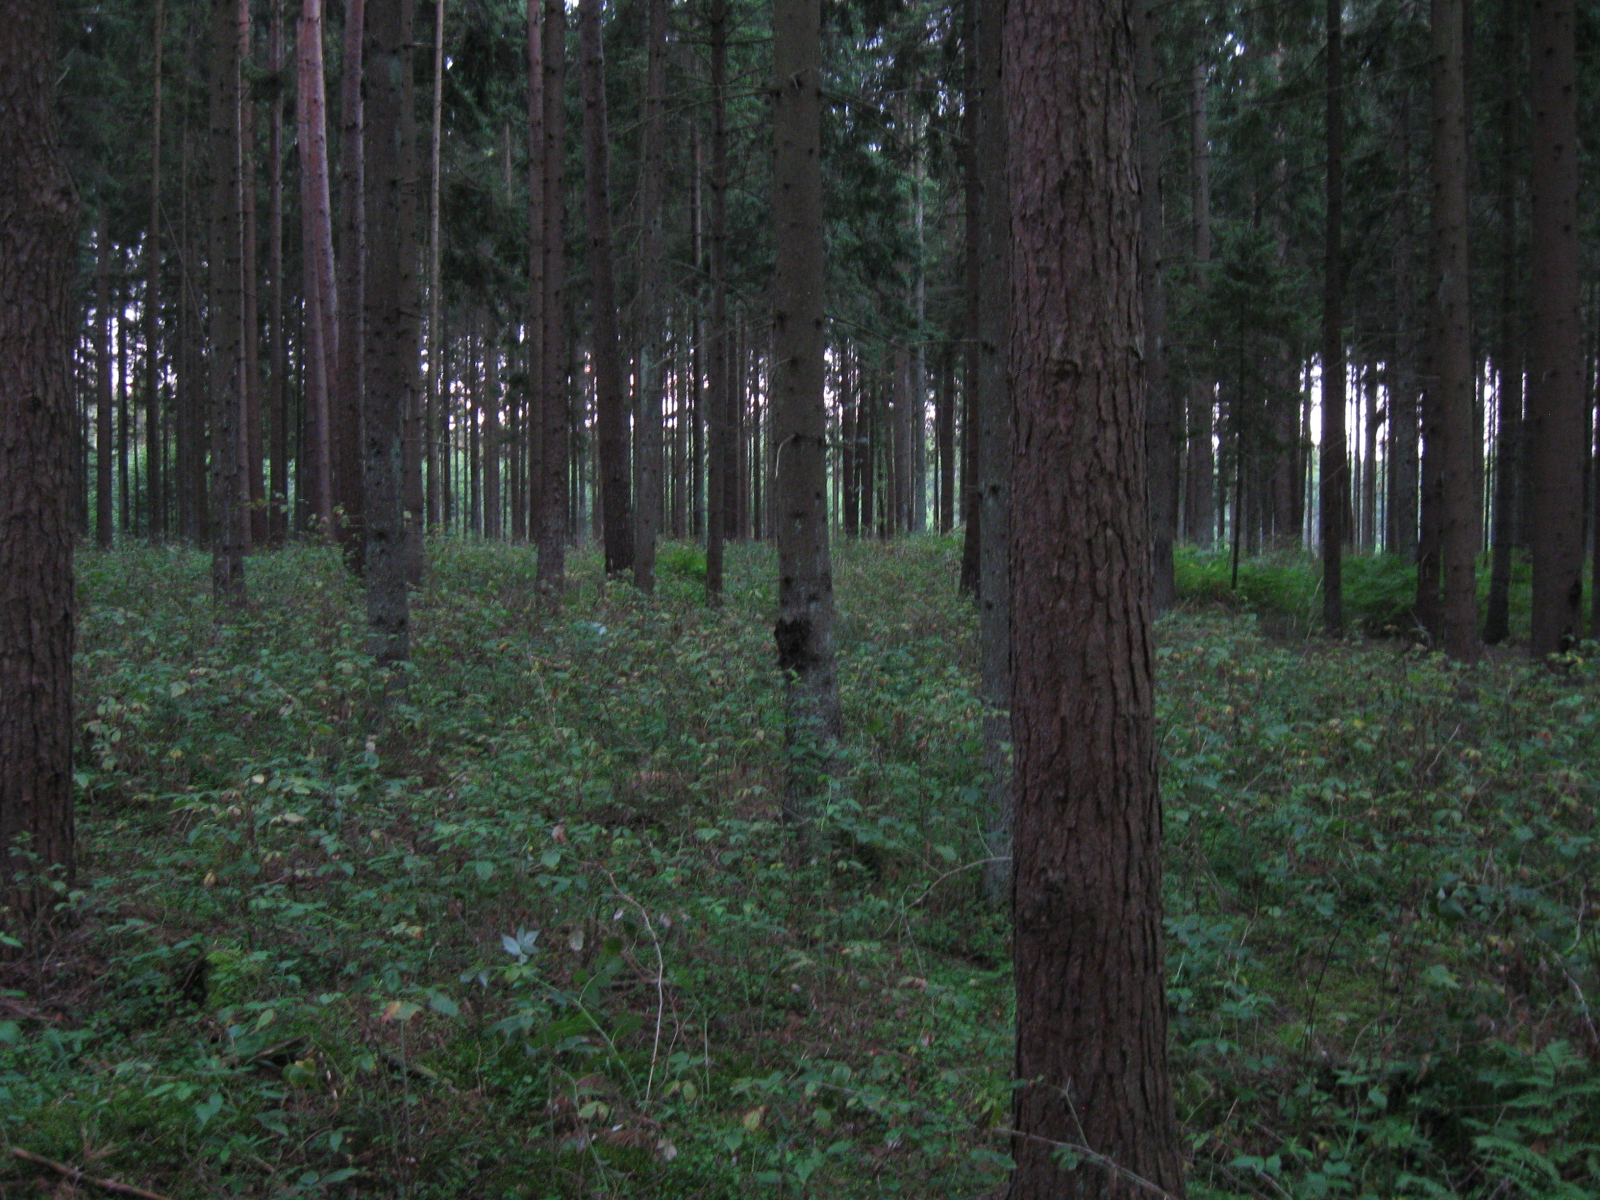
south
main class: Woodland
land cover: Pine dominated coniferous woodland
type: hemiboreal forest and nemoral coniferous forest and mixed broadleaved-coniferous forest
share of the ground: > 75 %
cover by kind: coniferous forest trees 75 %, herbaceous plants 10 %, lichens and mosses 10 %, shrubs 5 %
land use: Forestry
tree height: > 5 m
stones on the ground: < 10 %
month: August
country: LT
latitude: 54.6960
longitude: 23.5659
